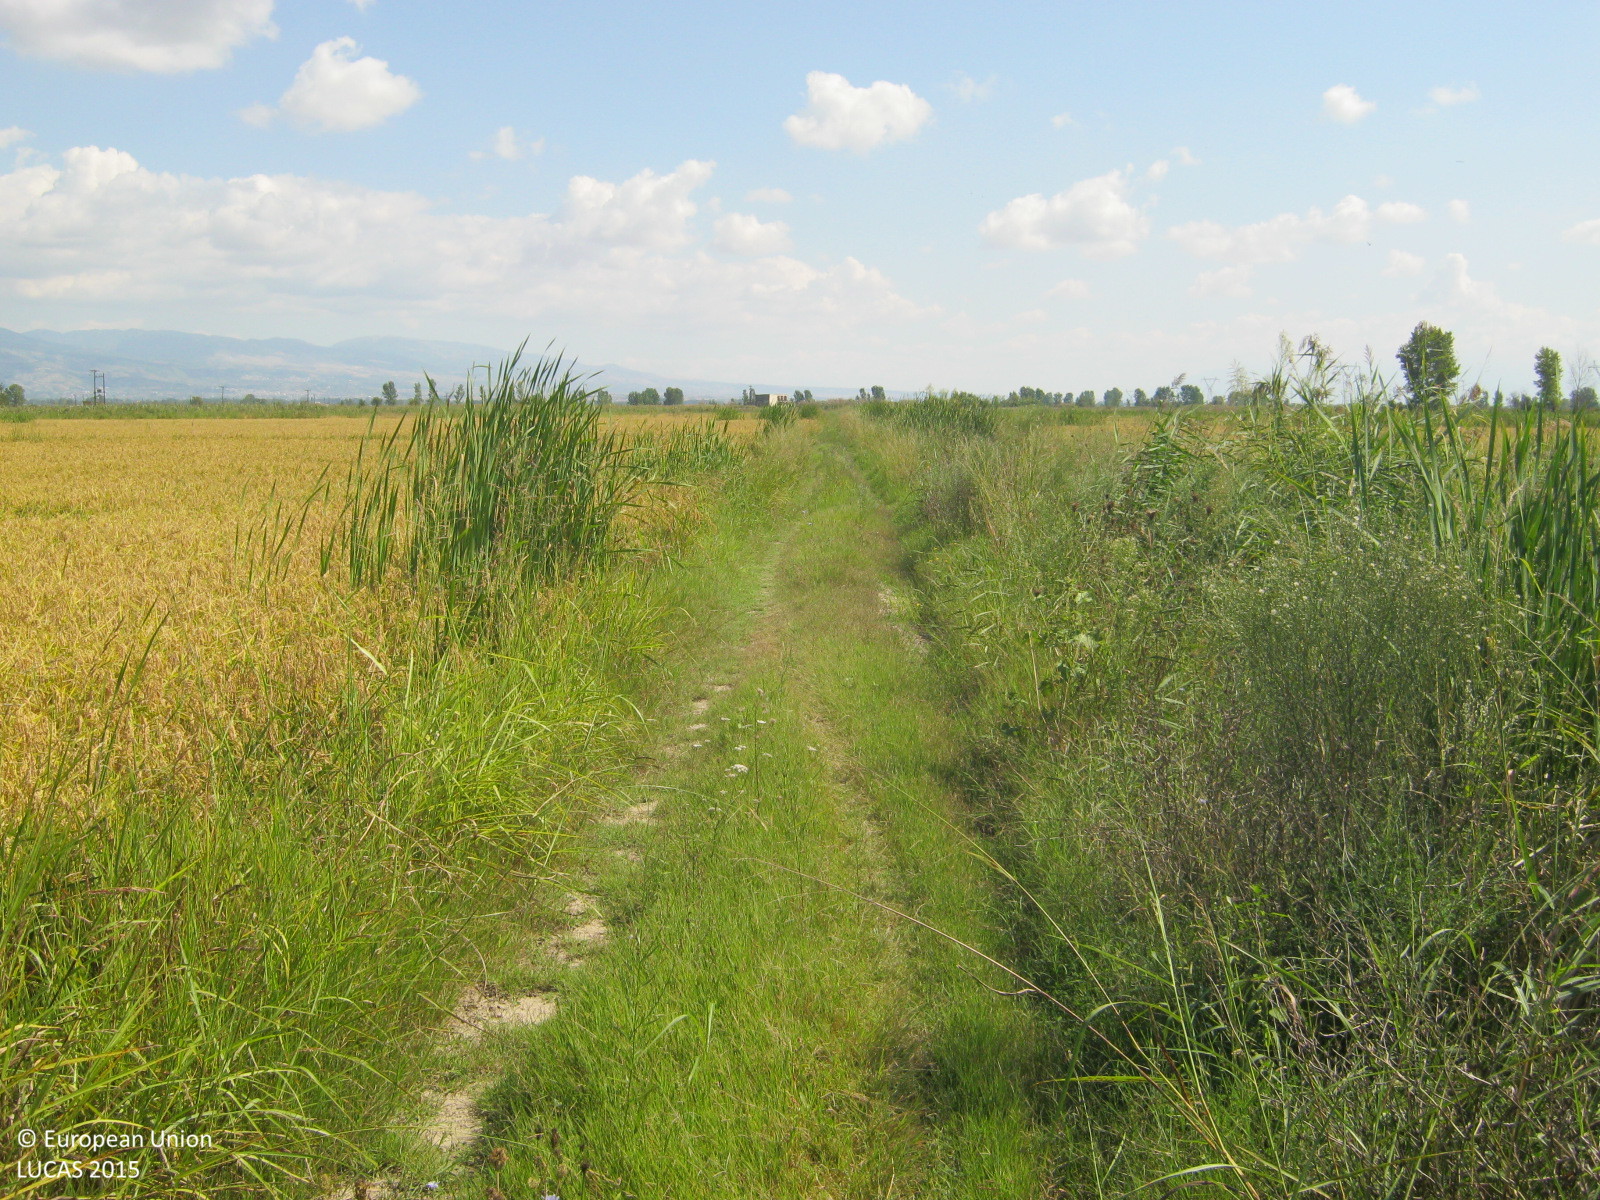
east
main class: Cropland
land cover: Rice
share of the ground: > 75 %
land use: Agriculture (excluding fallow land and kitchen gardens)
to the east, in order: Tracks
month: September
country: GR
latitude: 41.0538
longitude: 23.4755
